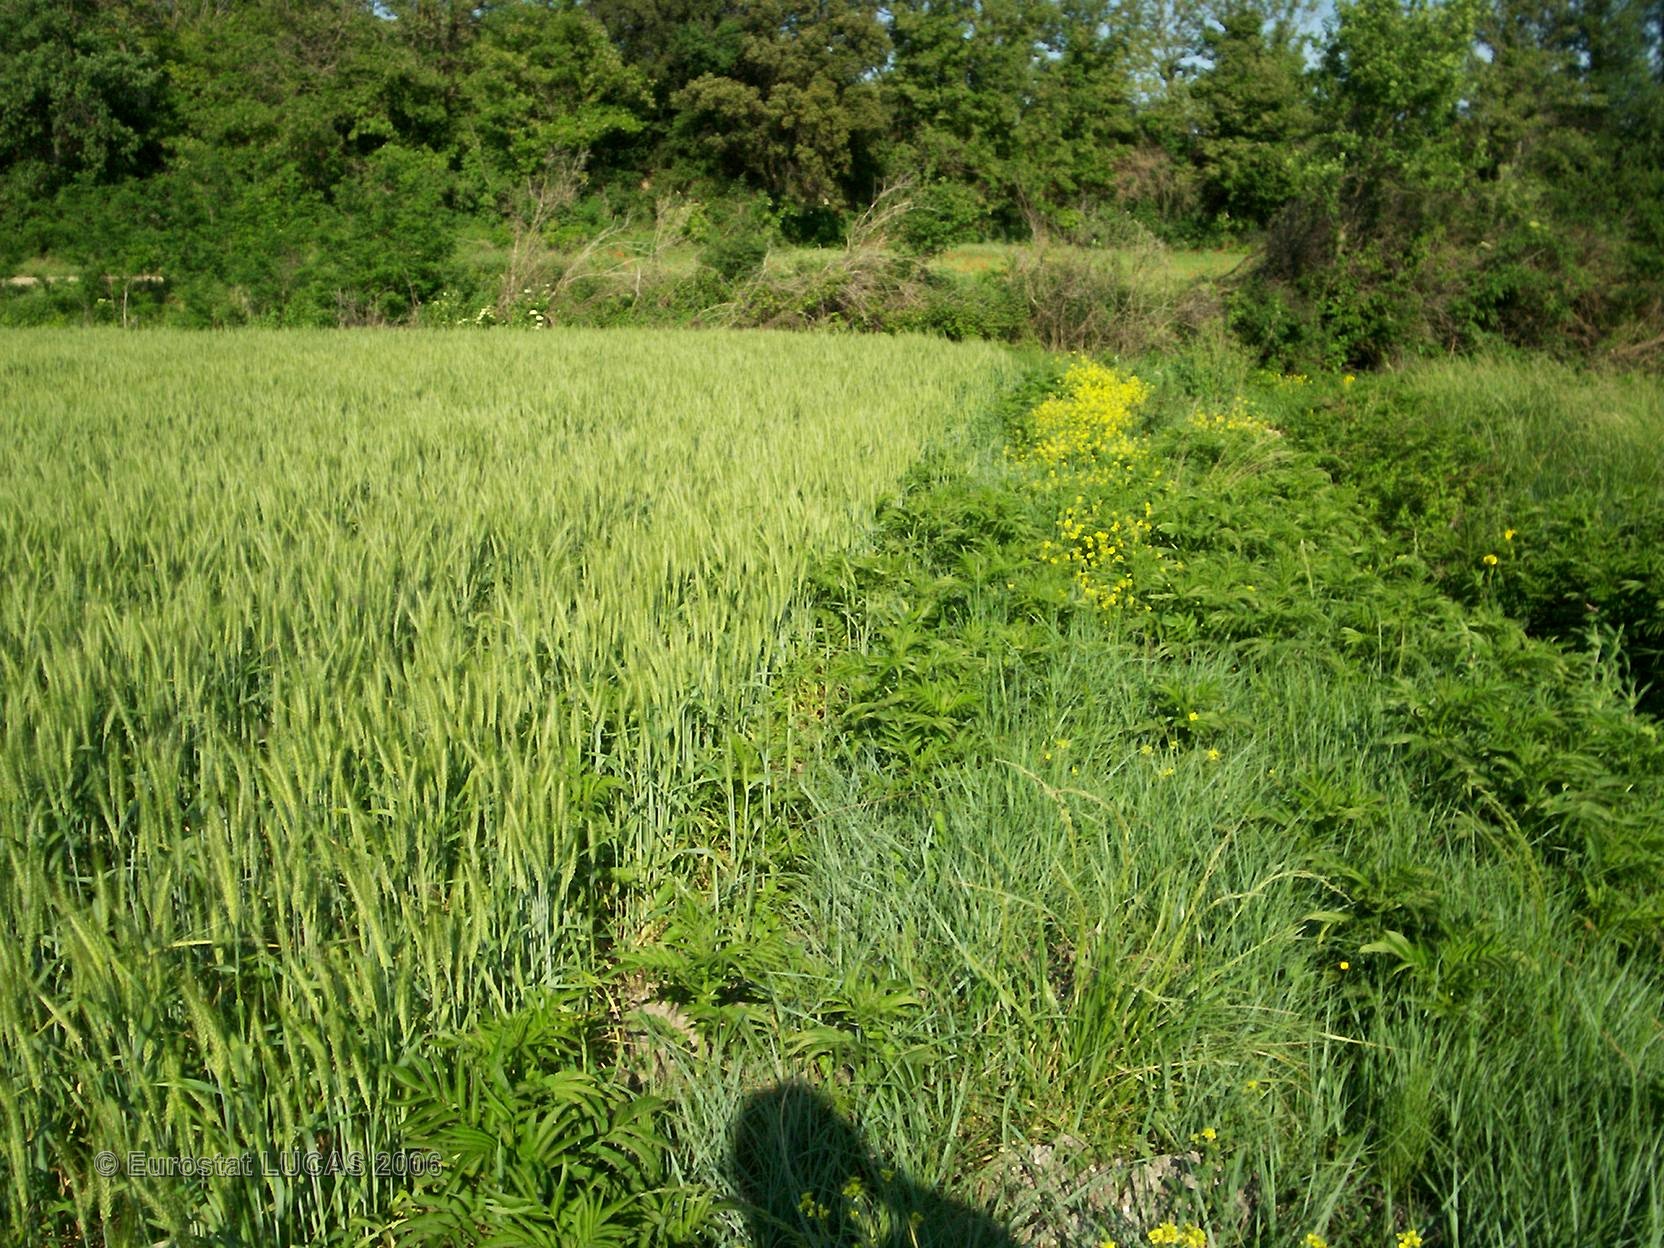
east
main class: Cropland
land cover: Barley
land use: Agriculture (excluding fallow land and kitchen gardens)
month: May
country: FR
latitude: 44.3313
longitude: 4.8531
